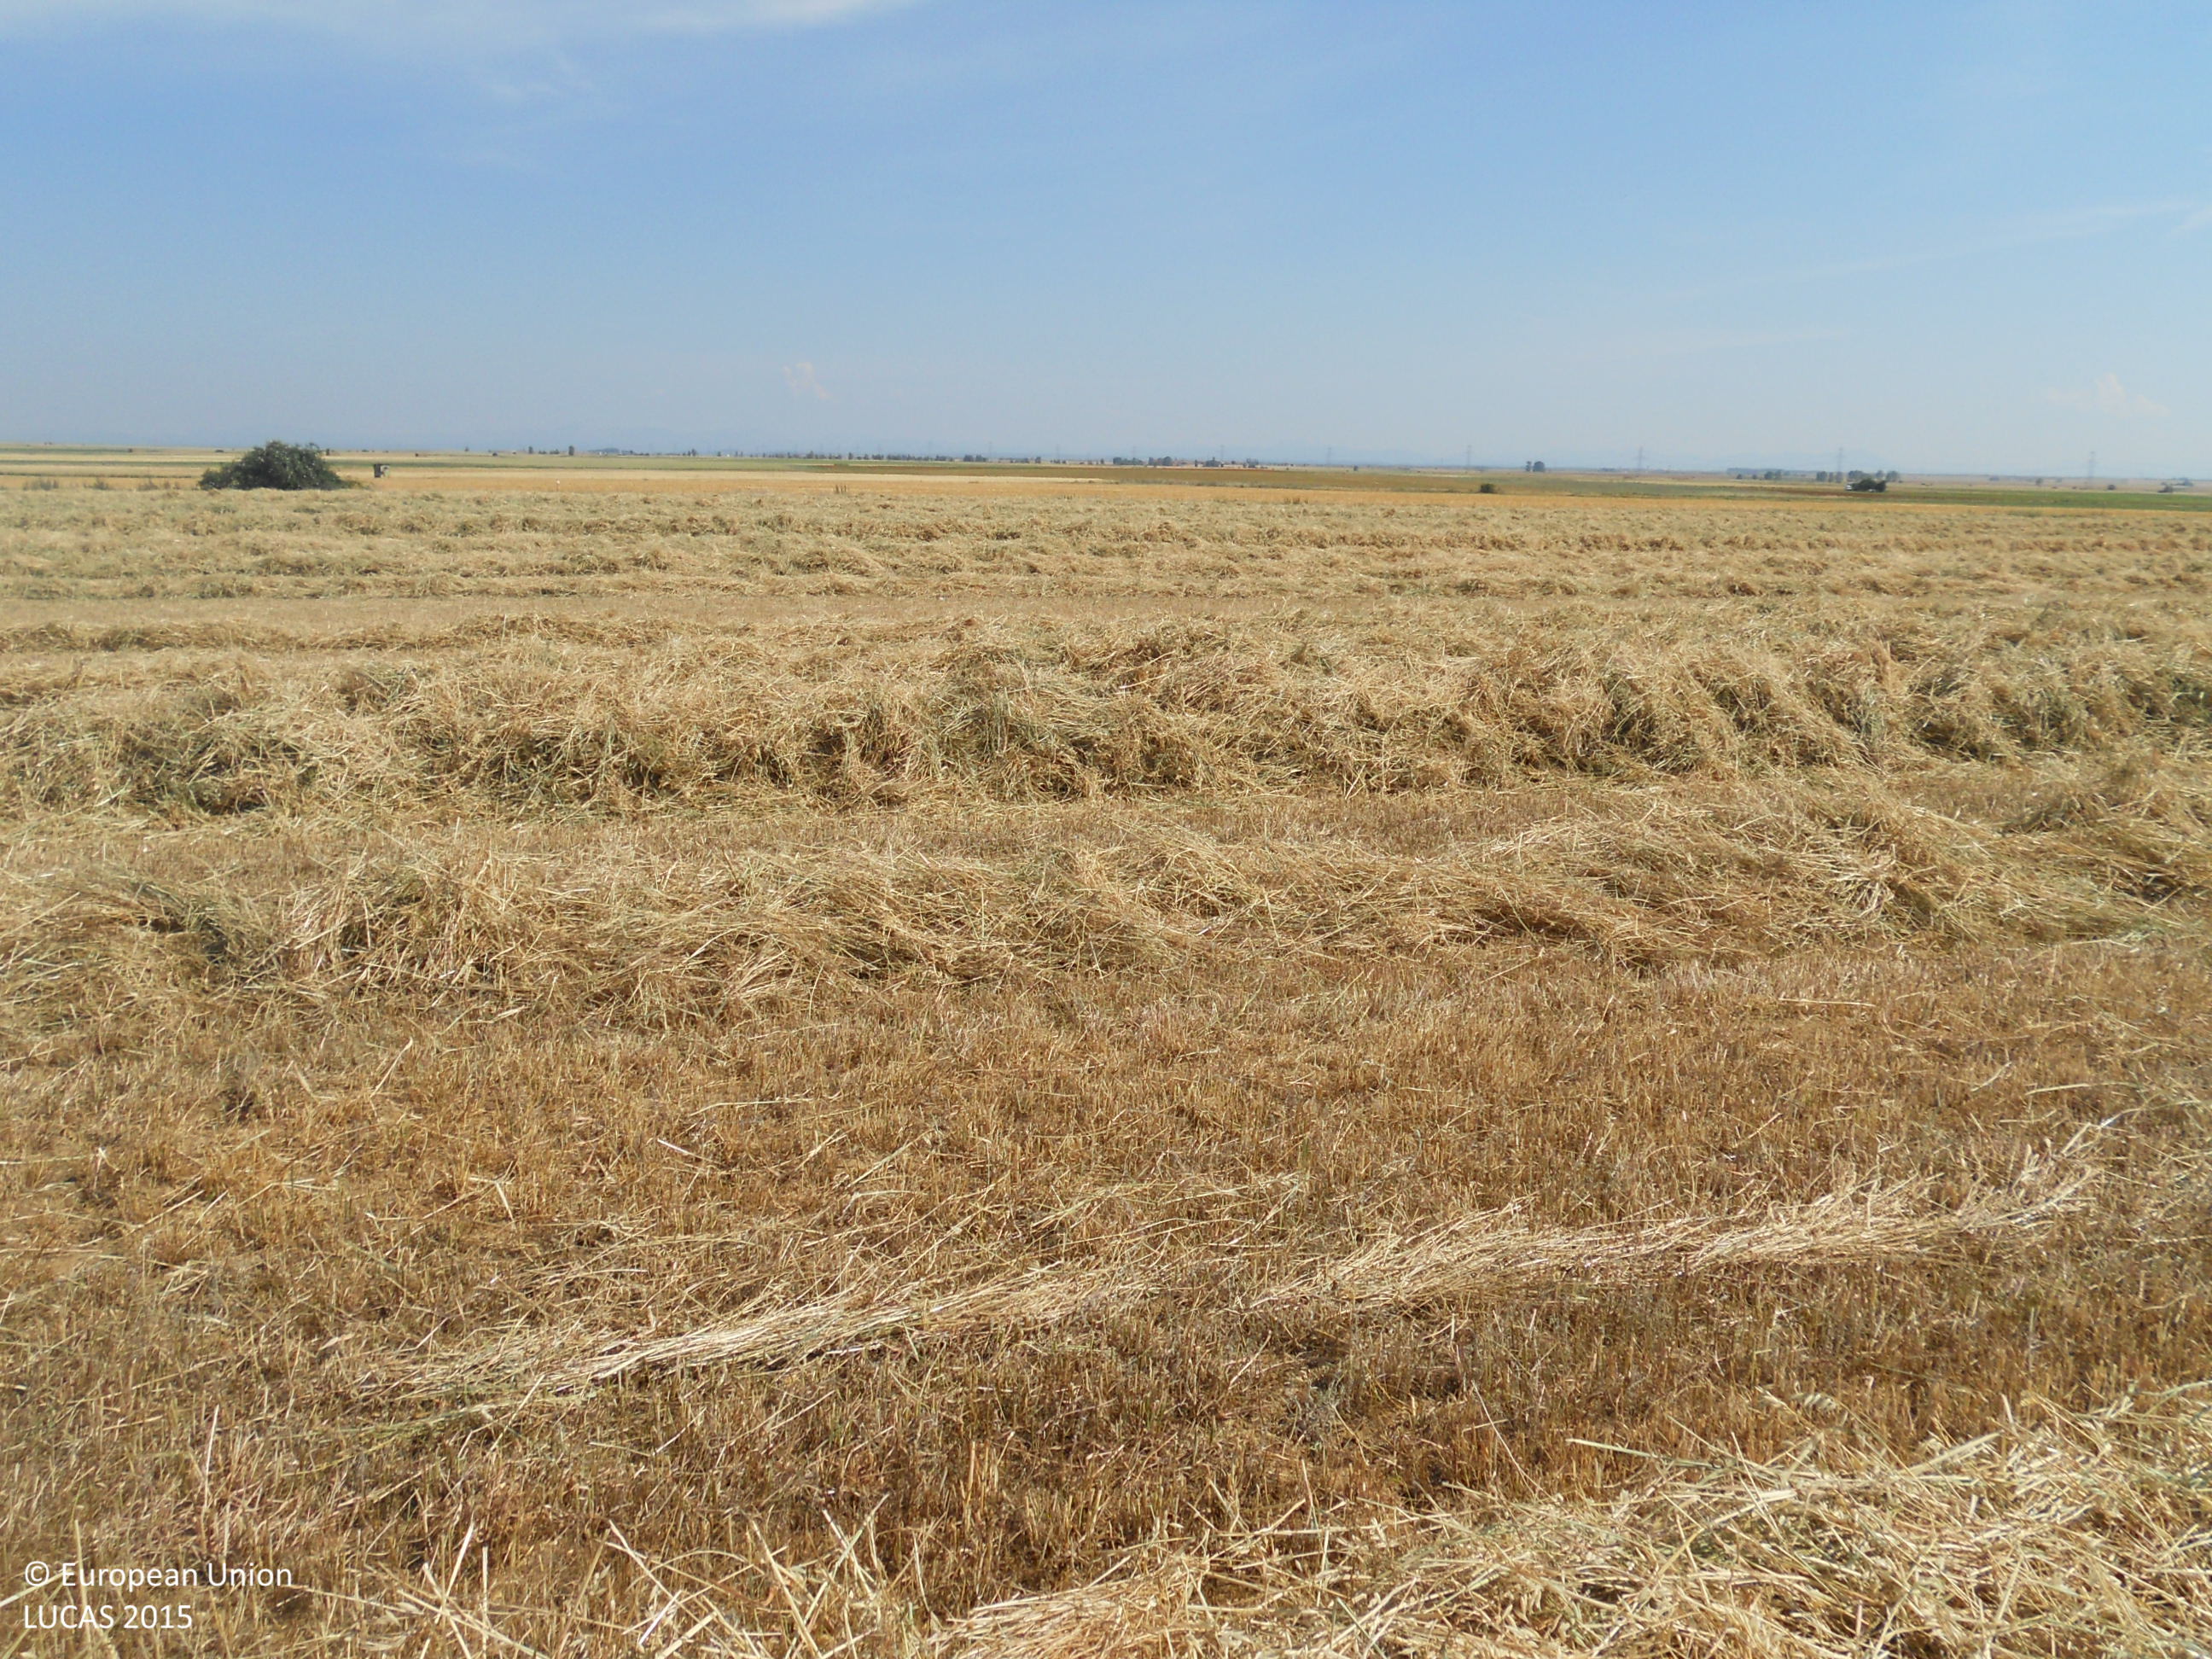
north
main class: Cropland
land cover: Mixed cereals for fodder
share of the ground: < 10 %
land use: Agriculture (excluding fallow land and kitchen gardens)
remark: Harvested field
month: June
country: ES
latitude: 42.3565
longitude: -5.3506
